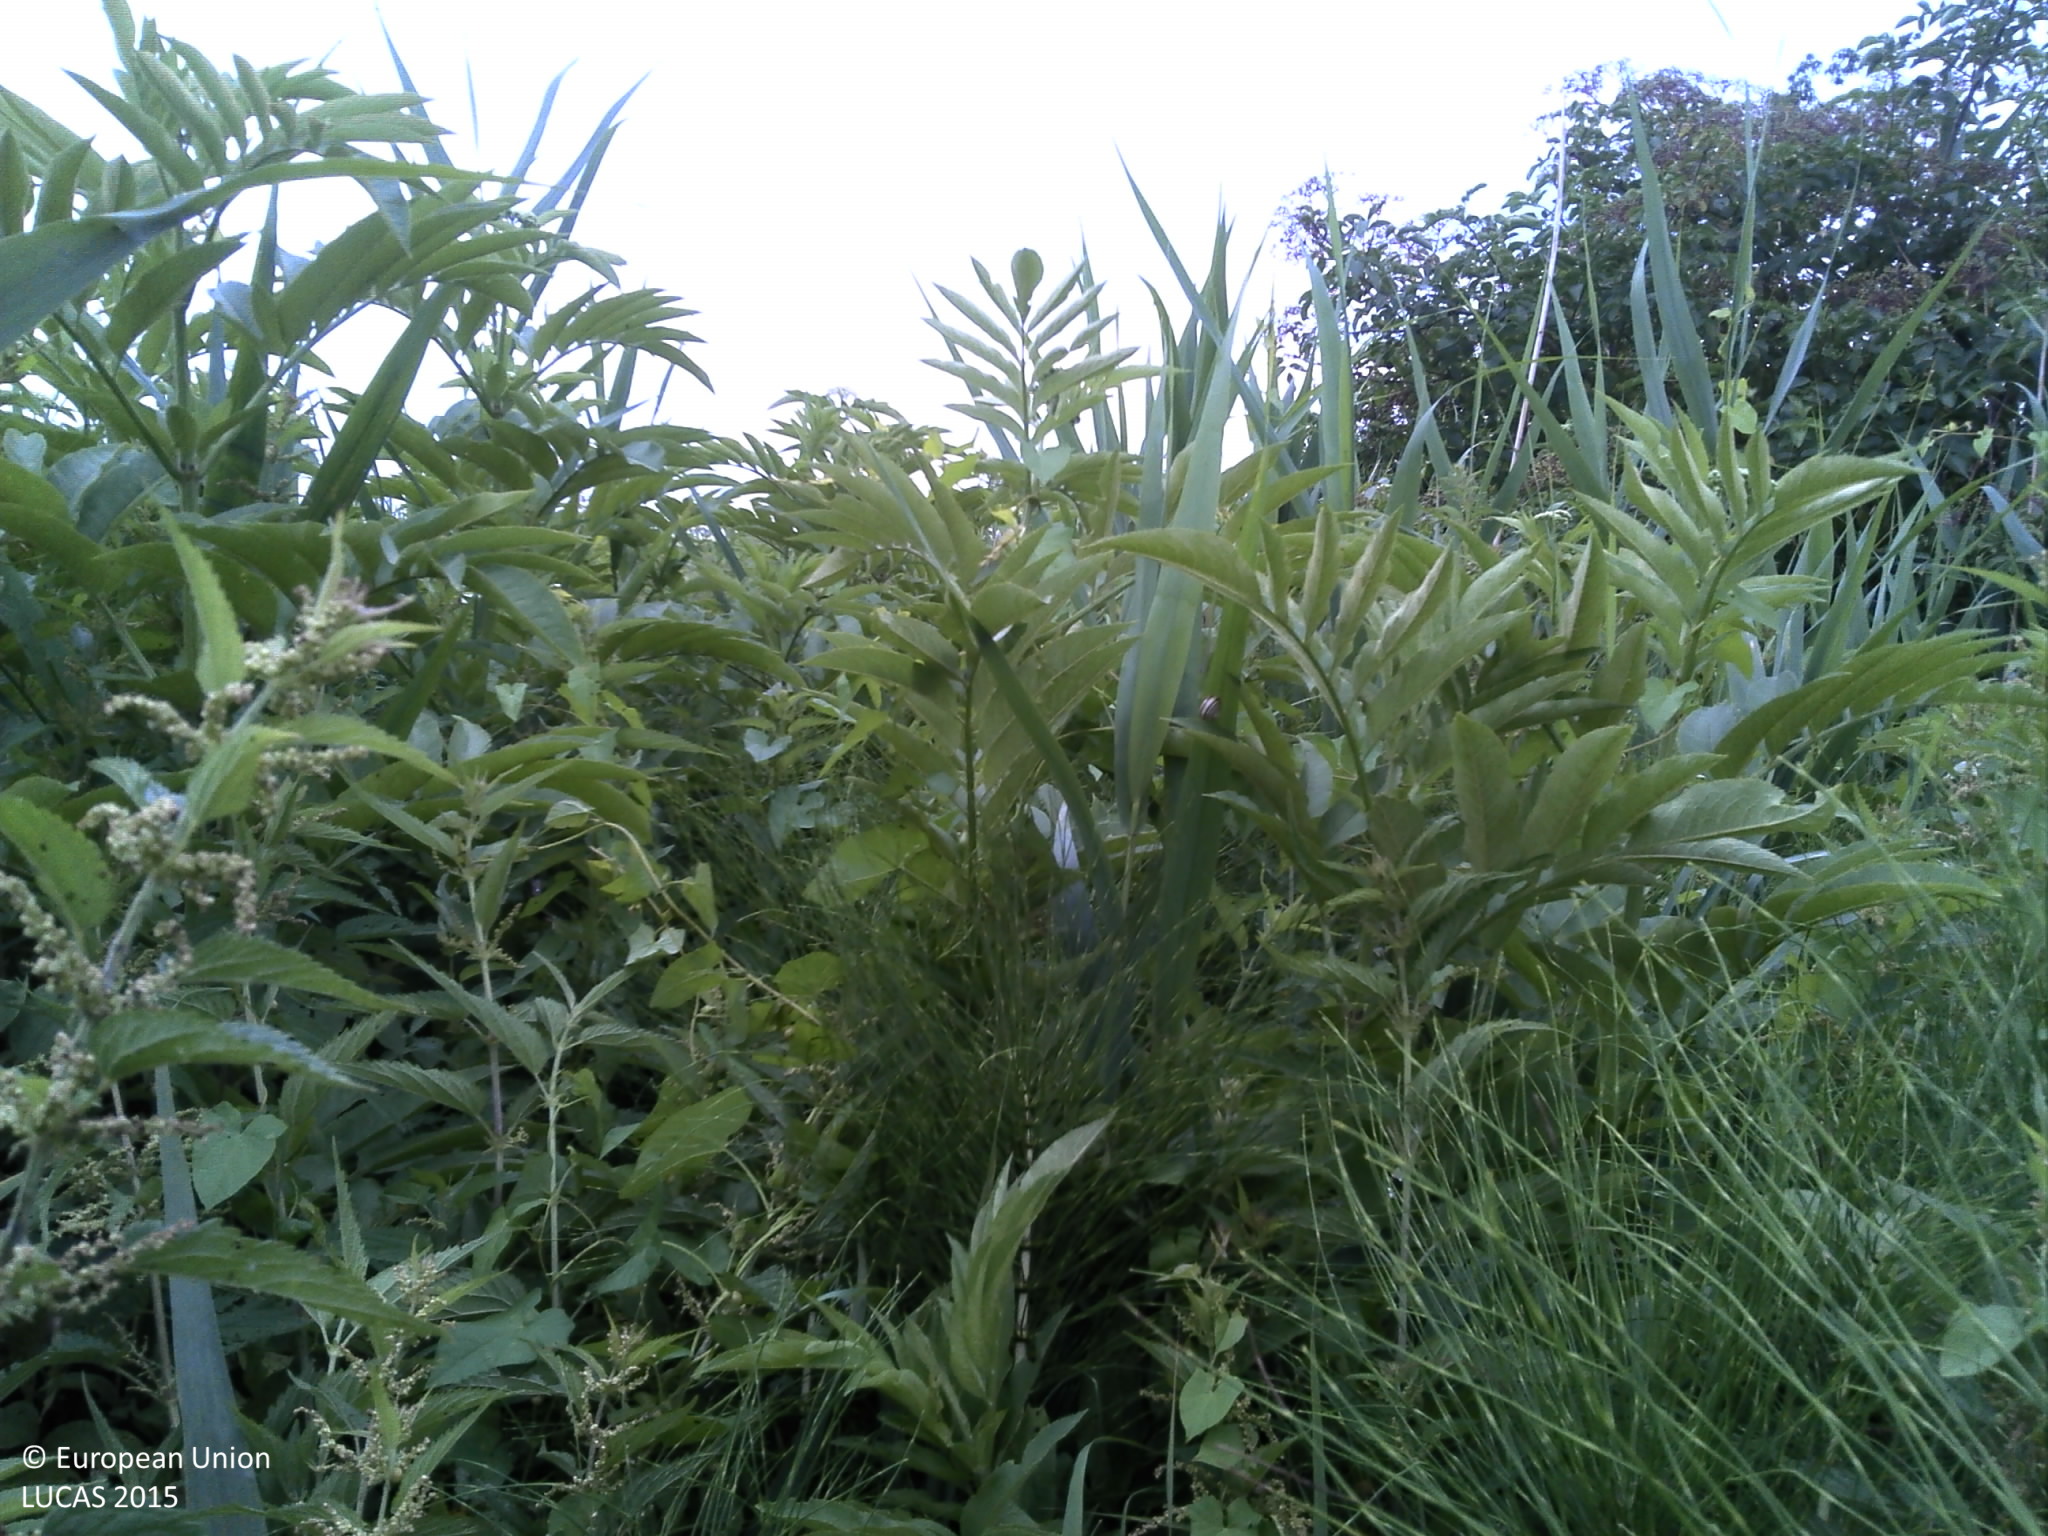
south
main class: Grassland
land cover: Spontaneously vegetated surfaces
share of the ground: > 75 %
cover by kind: herbaceous plants 90 %, shrubs 5 %, lichens and mosses 5 %
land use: Agriculture (excluding fallow land and kitchen gardens)
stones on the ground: < 10 %
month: June
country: HR
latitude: 45.2156
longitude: 17.5517
